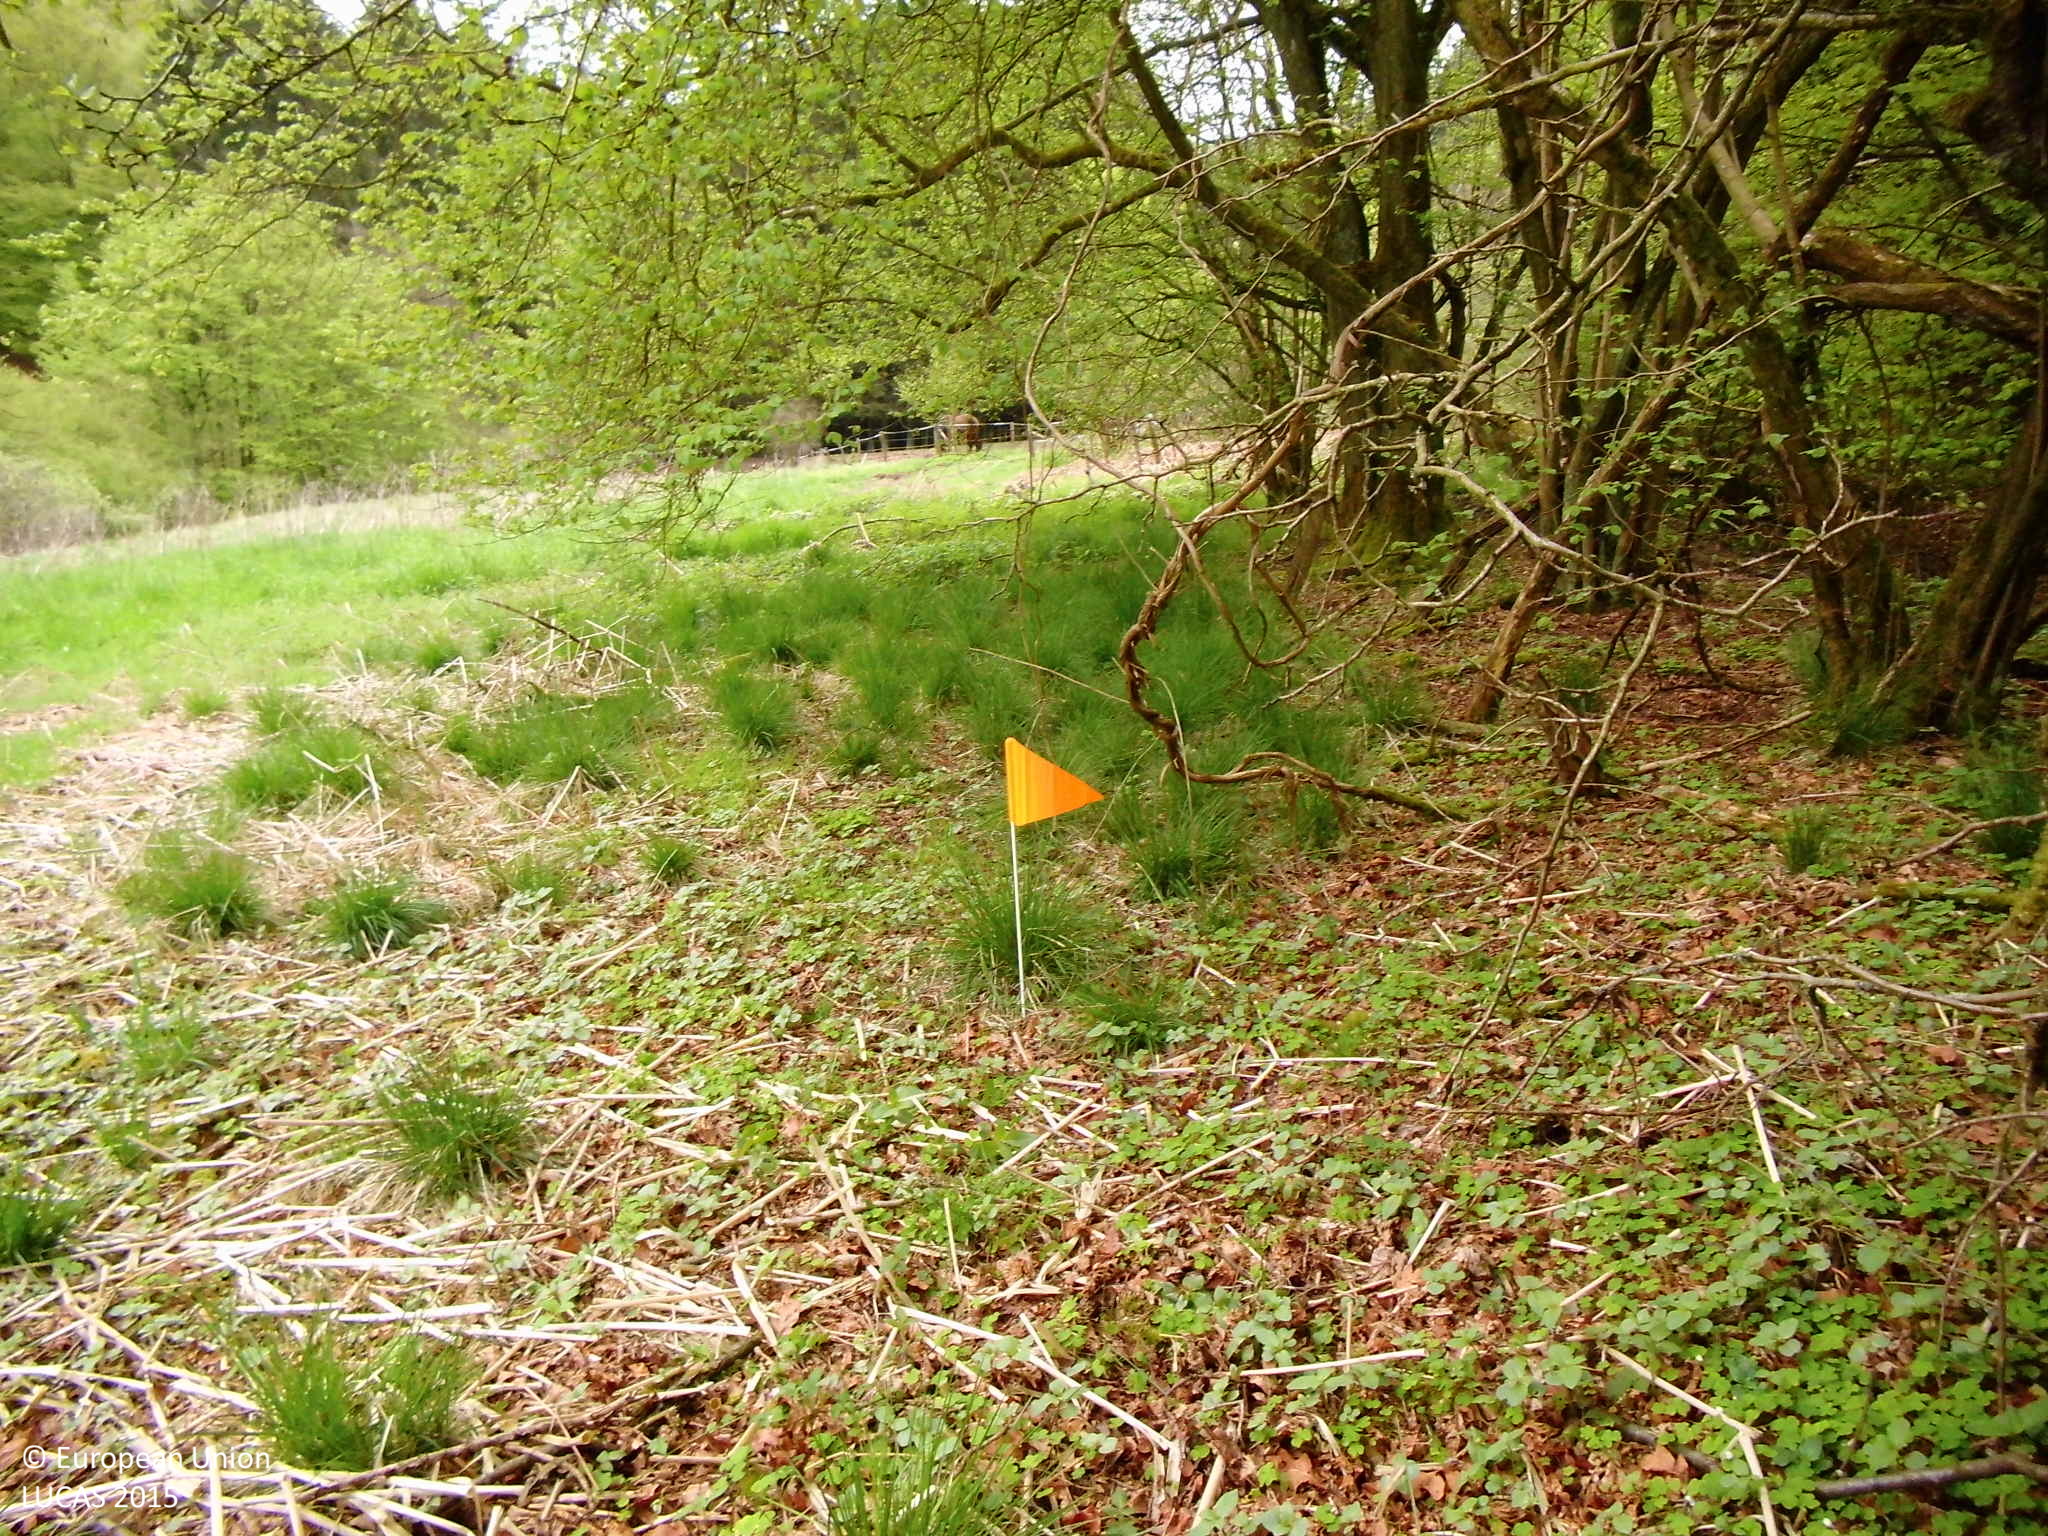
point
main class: Grassland
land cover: Grassland without tree/shrub cover
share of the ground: > 75 %
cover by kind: herbaceous plants 75 %, unconsolidated bare surface 20 %, shrubs 5 %
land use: Agriculture (excluding fallow land and kitchen gardens)
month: May
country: DE
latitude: 51.2540
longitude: 7.4928
